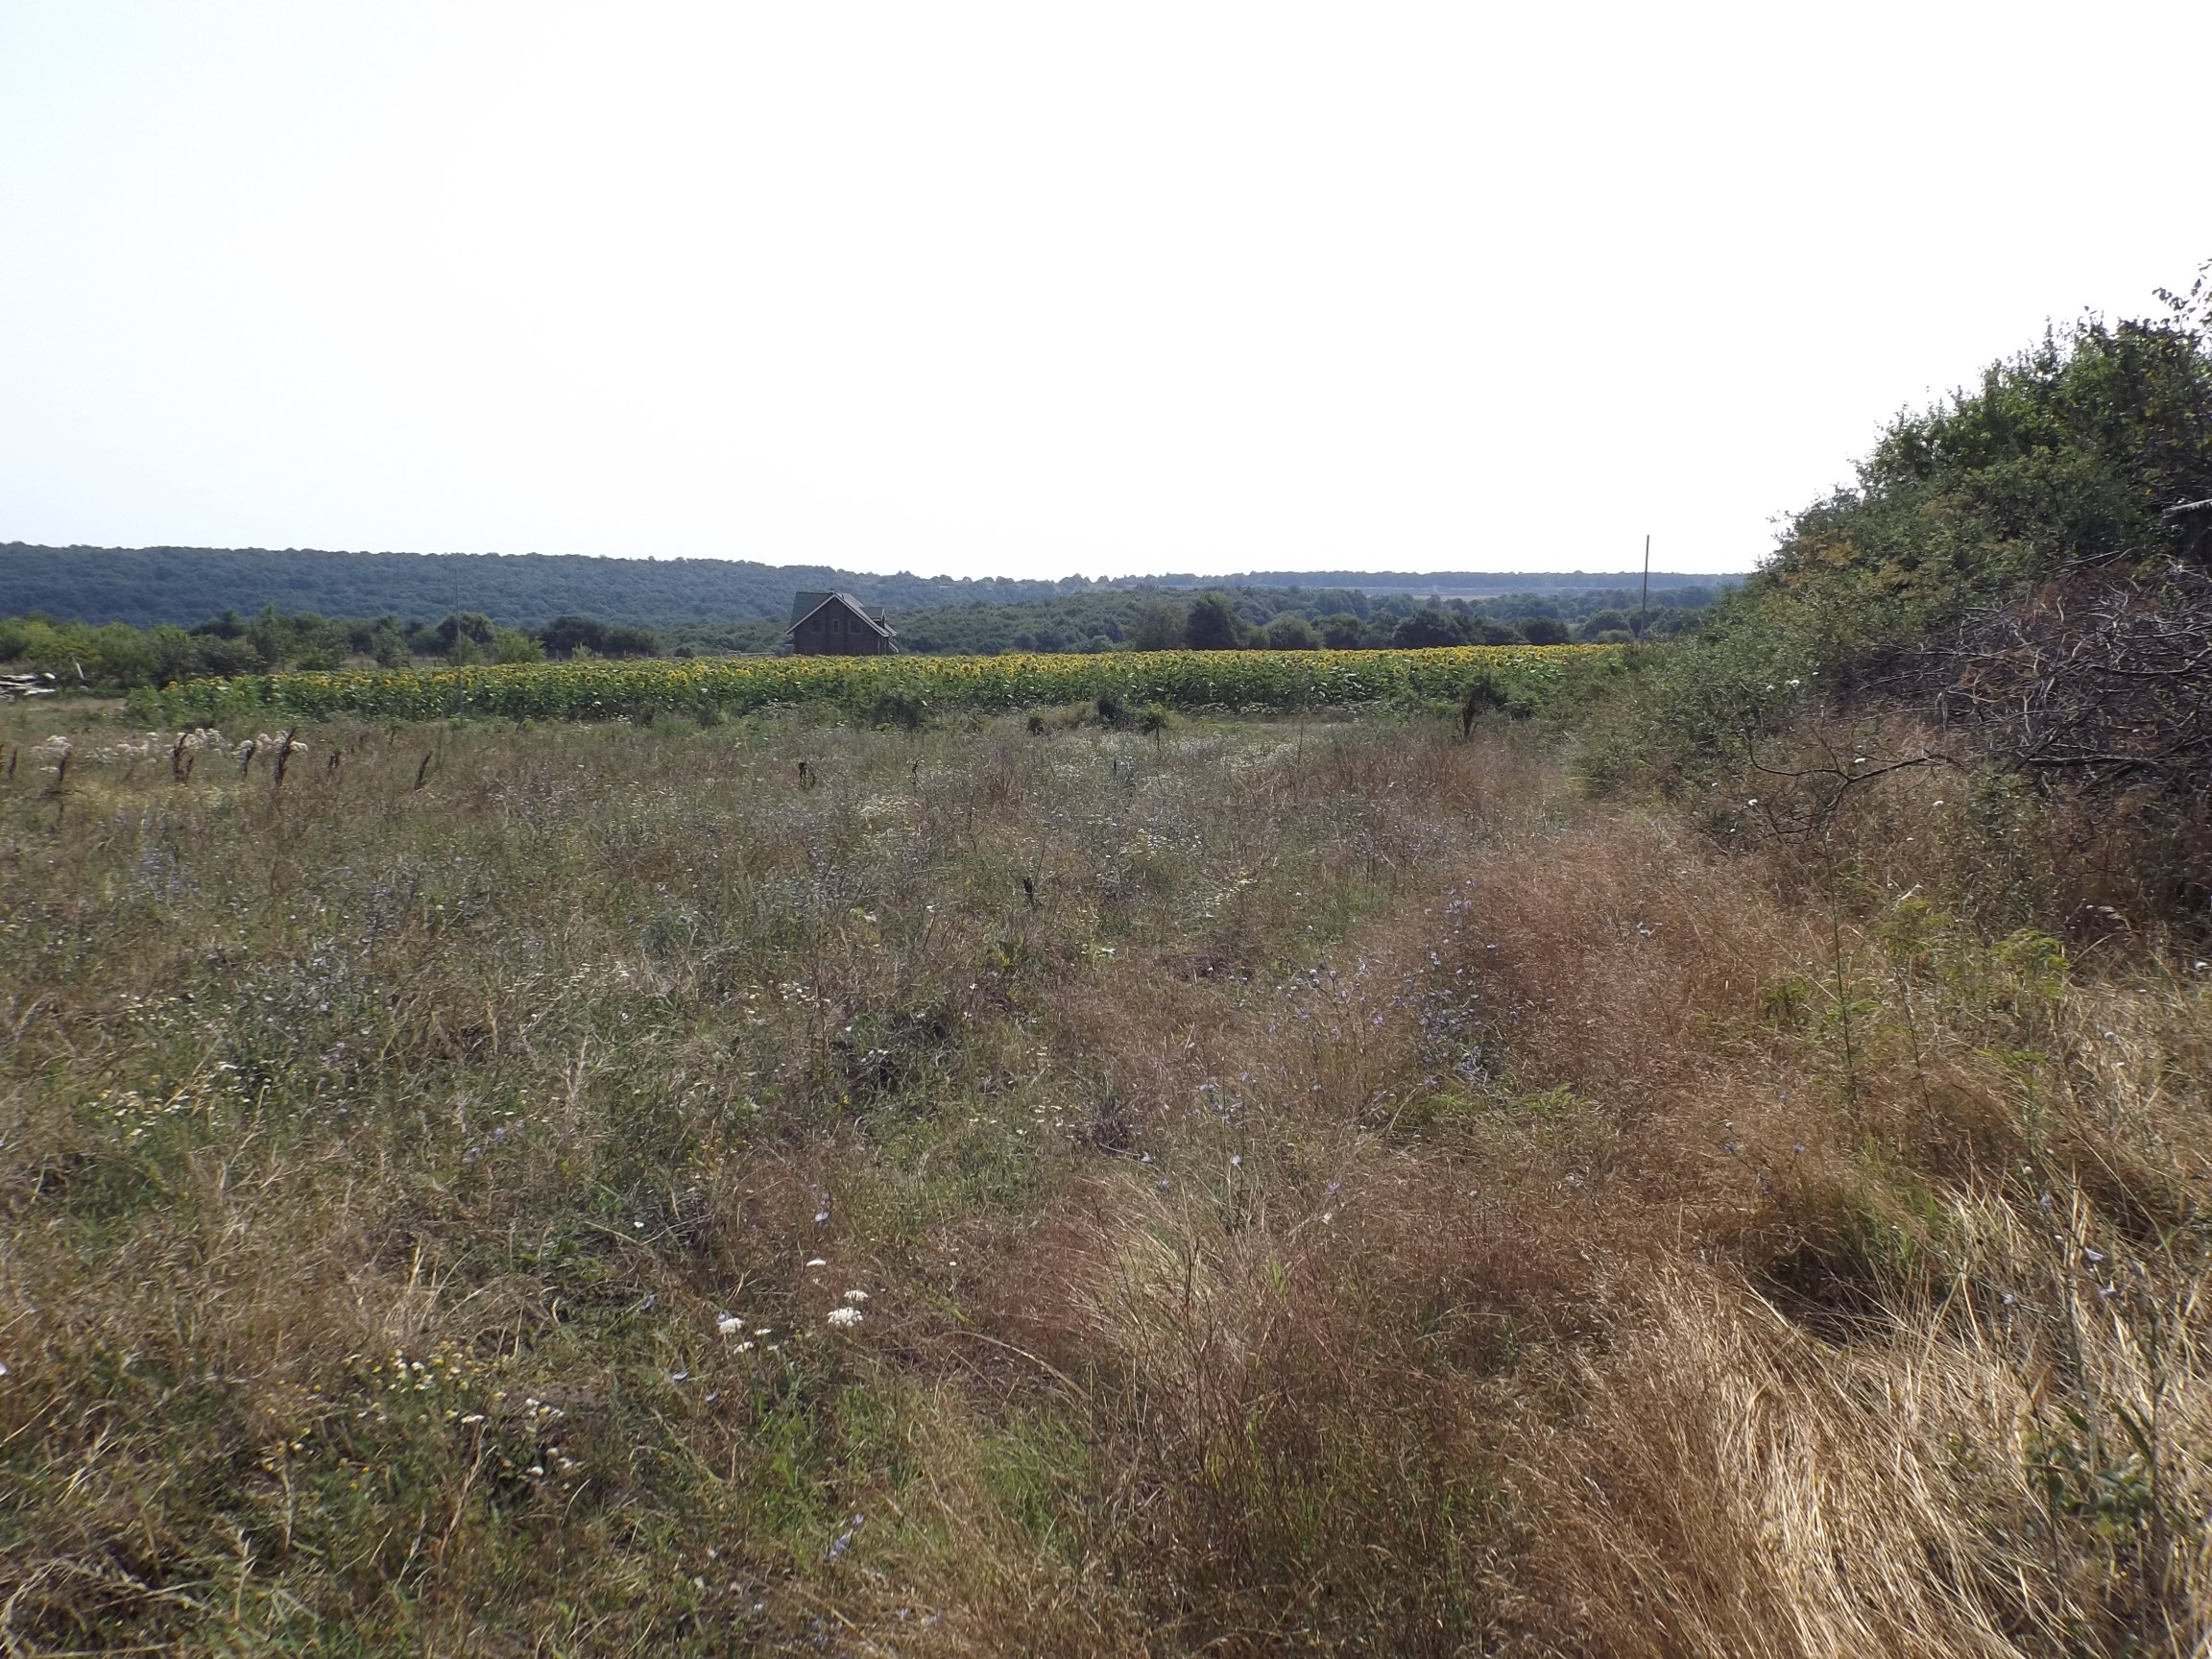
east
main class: Grassland
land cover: Spontaneously vegetated surfaces
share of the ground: > 75 %
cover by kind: herbaceous plants 100 %
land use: Fallow land
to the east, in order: Spontaneously vegetated surfaces; Grass margins; Tracks; Sunflower; Fences; Grassland without tree/shrub cover; Artificial constructions in urban areas; Grassland without tree/shrub cover; Fences; Tracks; Broadleaved woodland
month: July
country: BG
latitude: 43.2989
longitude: 27.8773
